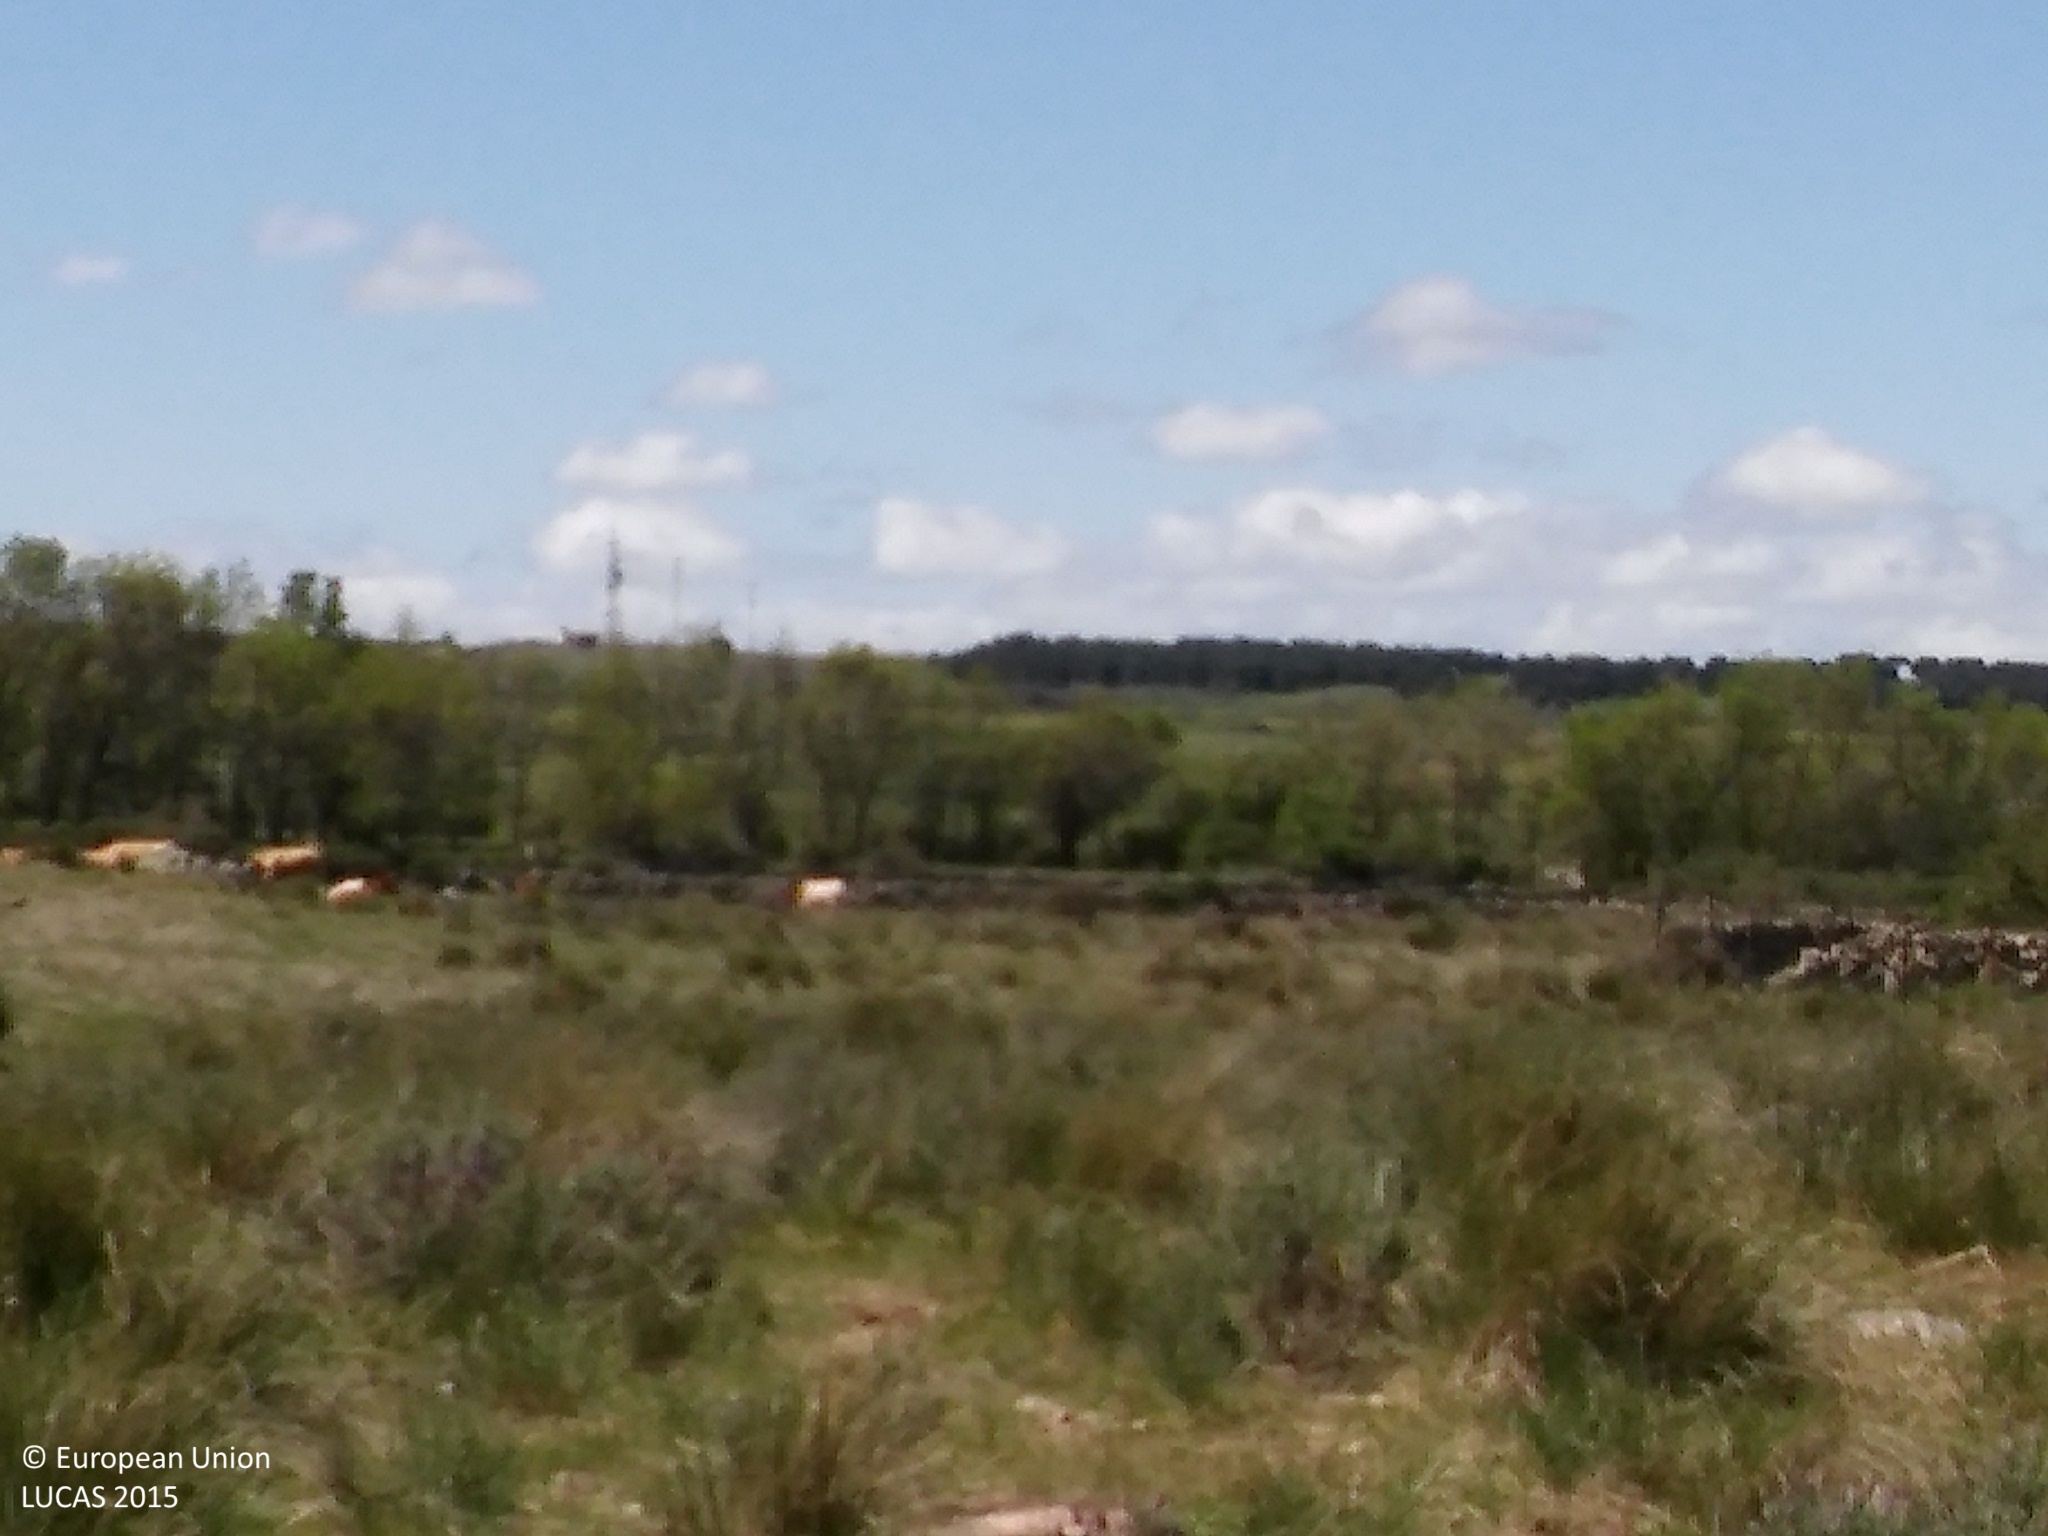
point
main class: Grassland
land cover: Grassland without tree/shrub cover
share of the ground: > 75 %
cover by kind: herbaceous plants 95 %, consolidated bare surface 5 %
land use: Agriculture (excluding fallow land and kitchen gardens)
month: May
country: ES
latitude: 41.0207
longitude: -3.9749
